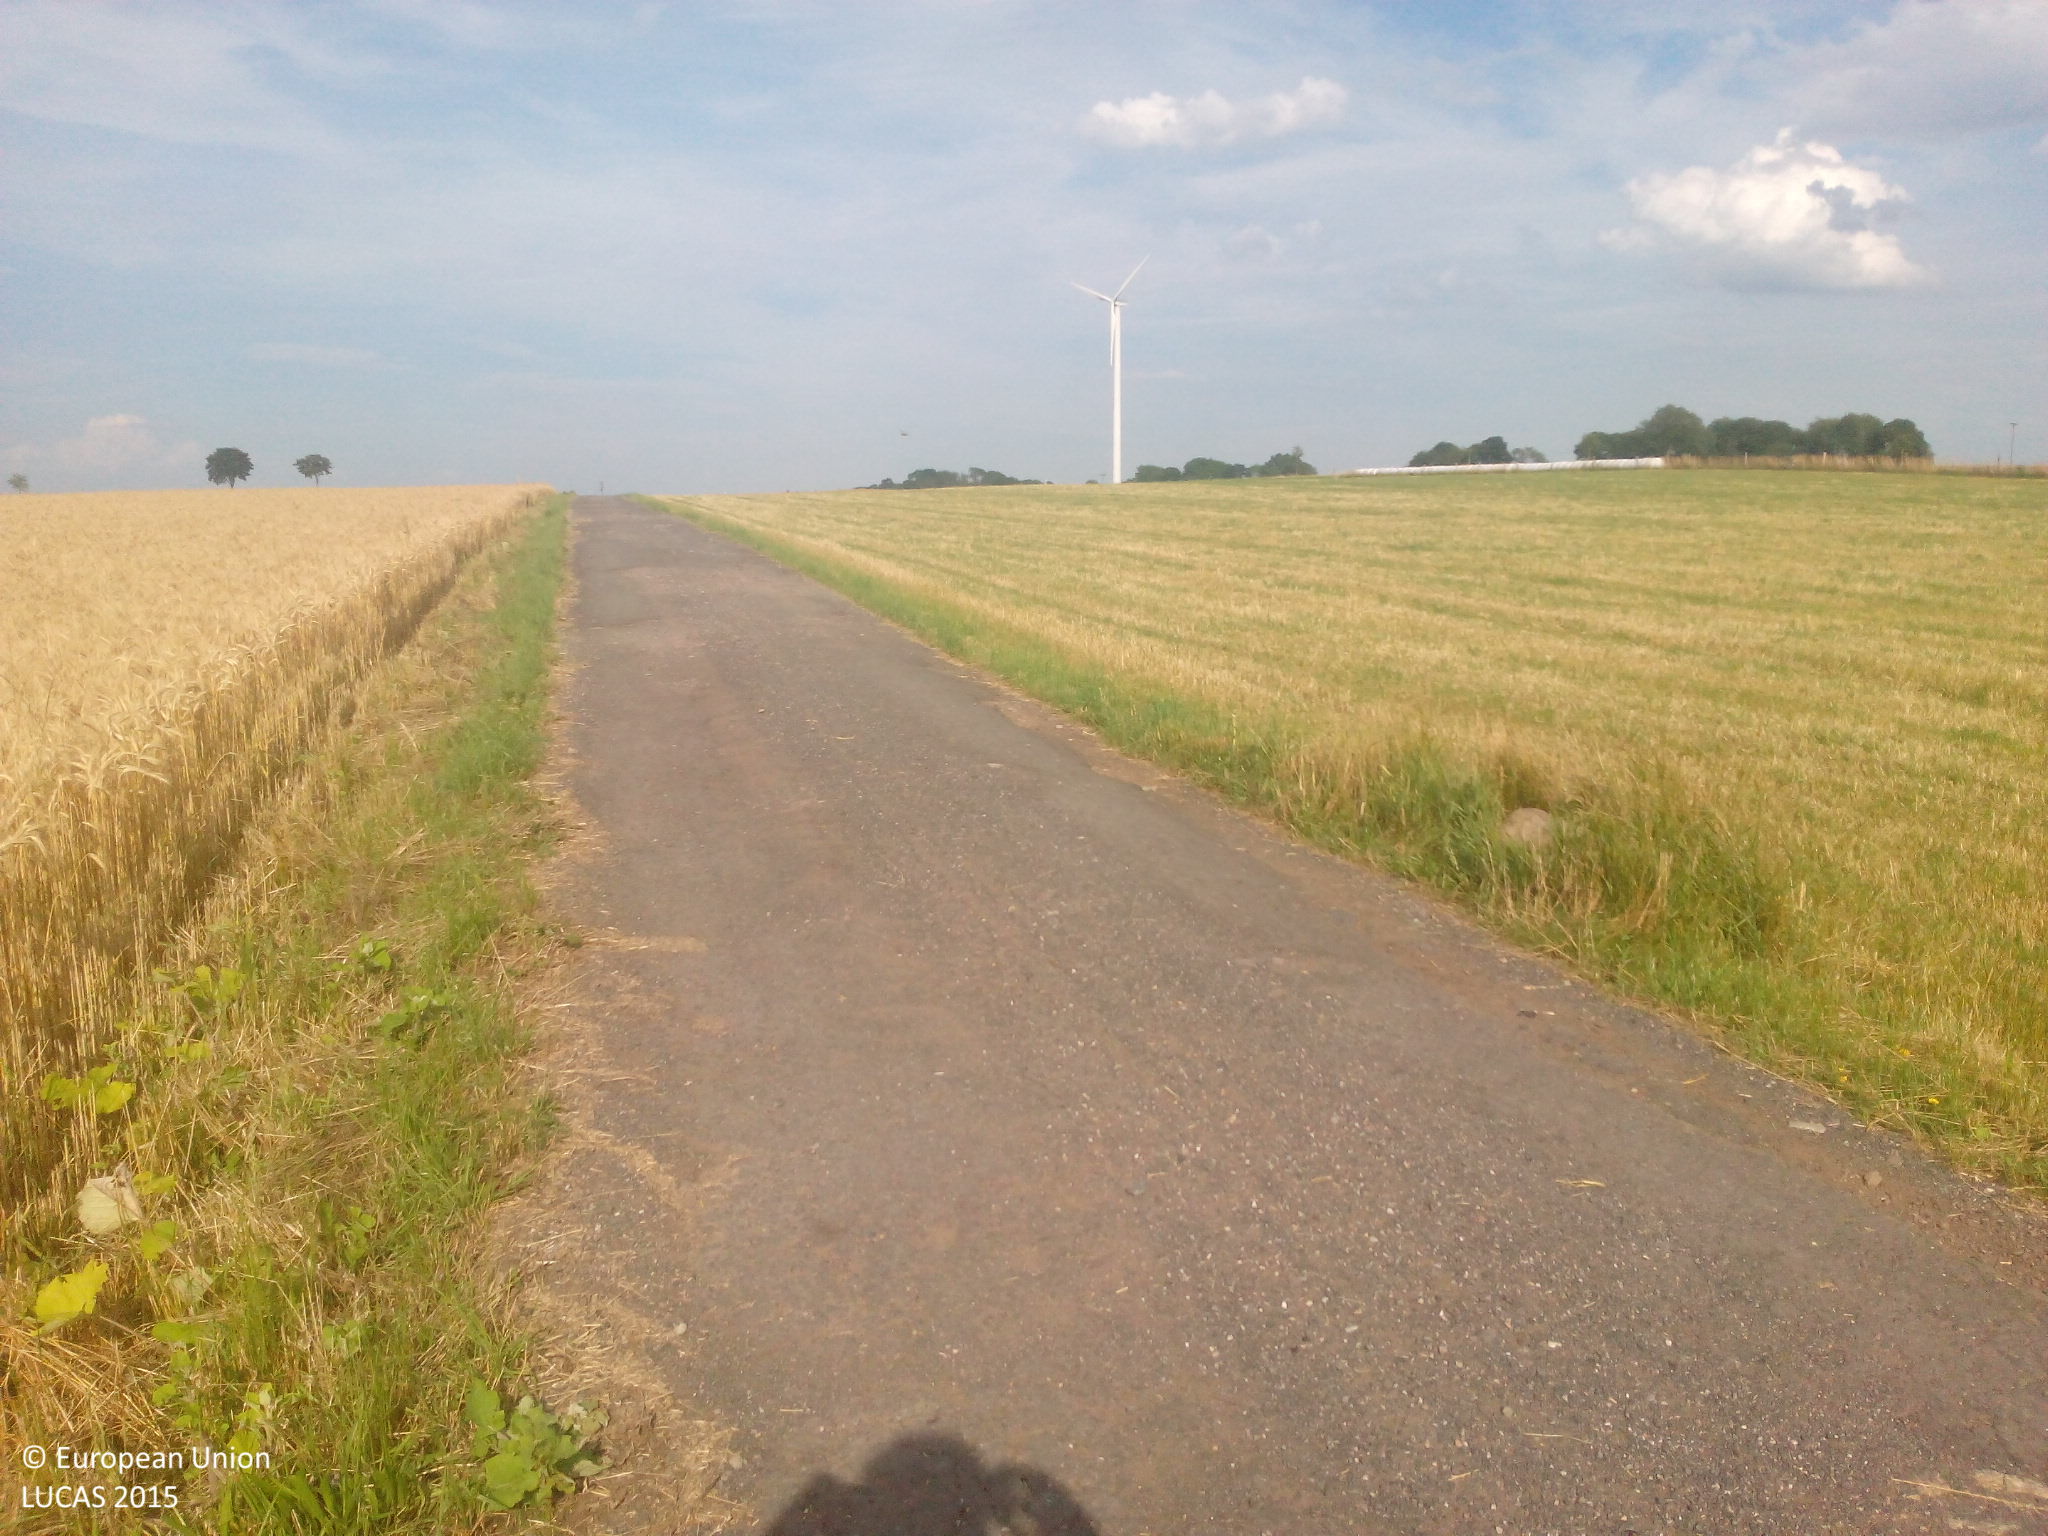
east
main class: Cropland
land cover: Triticale
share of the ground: > 75 %
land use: Agriculture (excluding fallow land and kitchen gardens)
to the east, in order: Triticale; Grass margins; Paved roads, cycling and walking lanes; Temporary grasslands
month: July
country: DE
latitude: 50.9040
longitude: 13.5129
